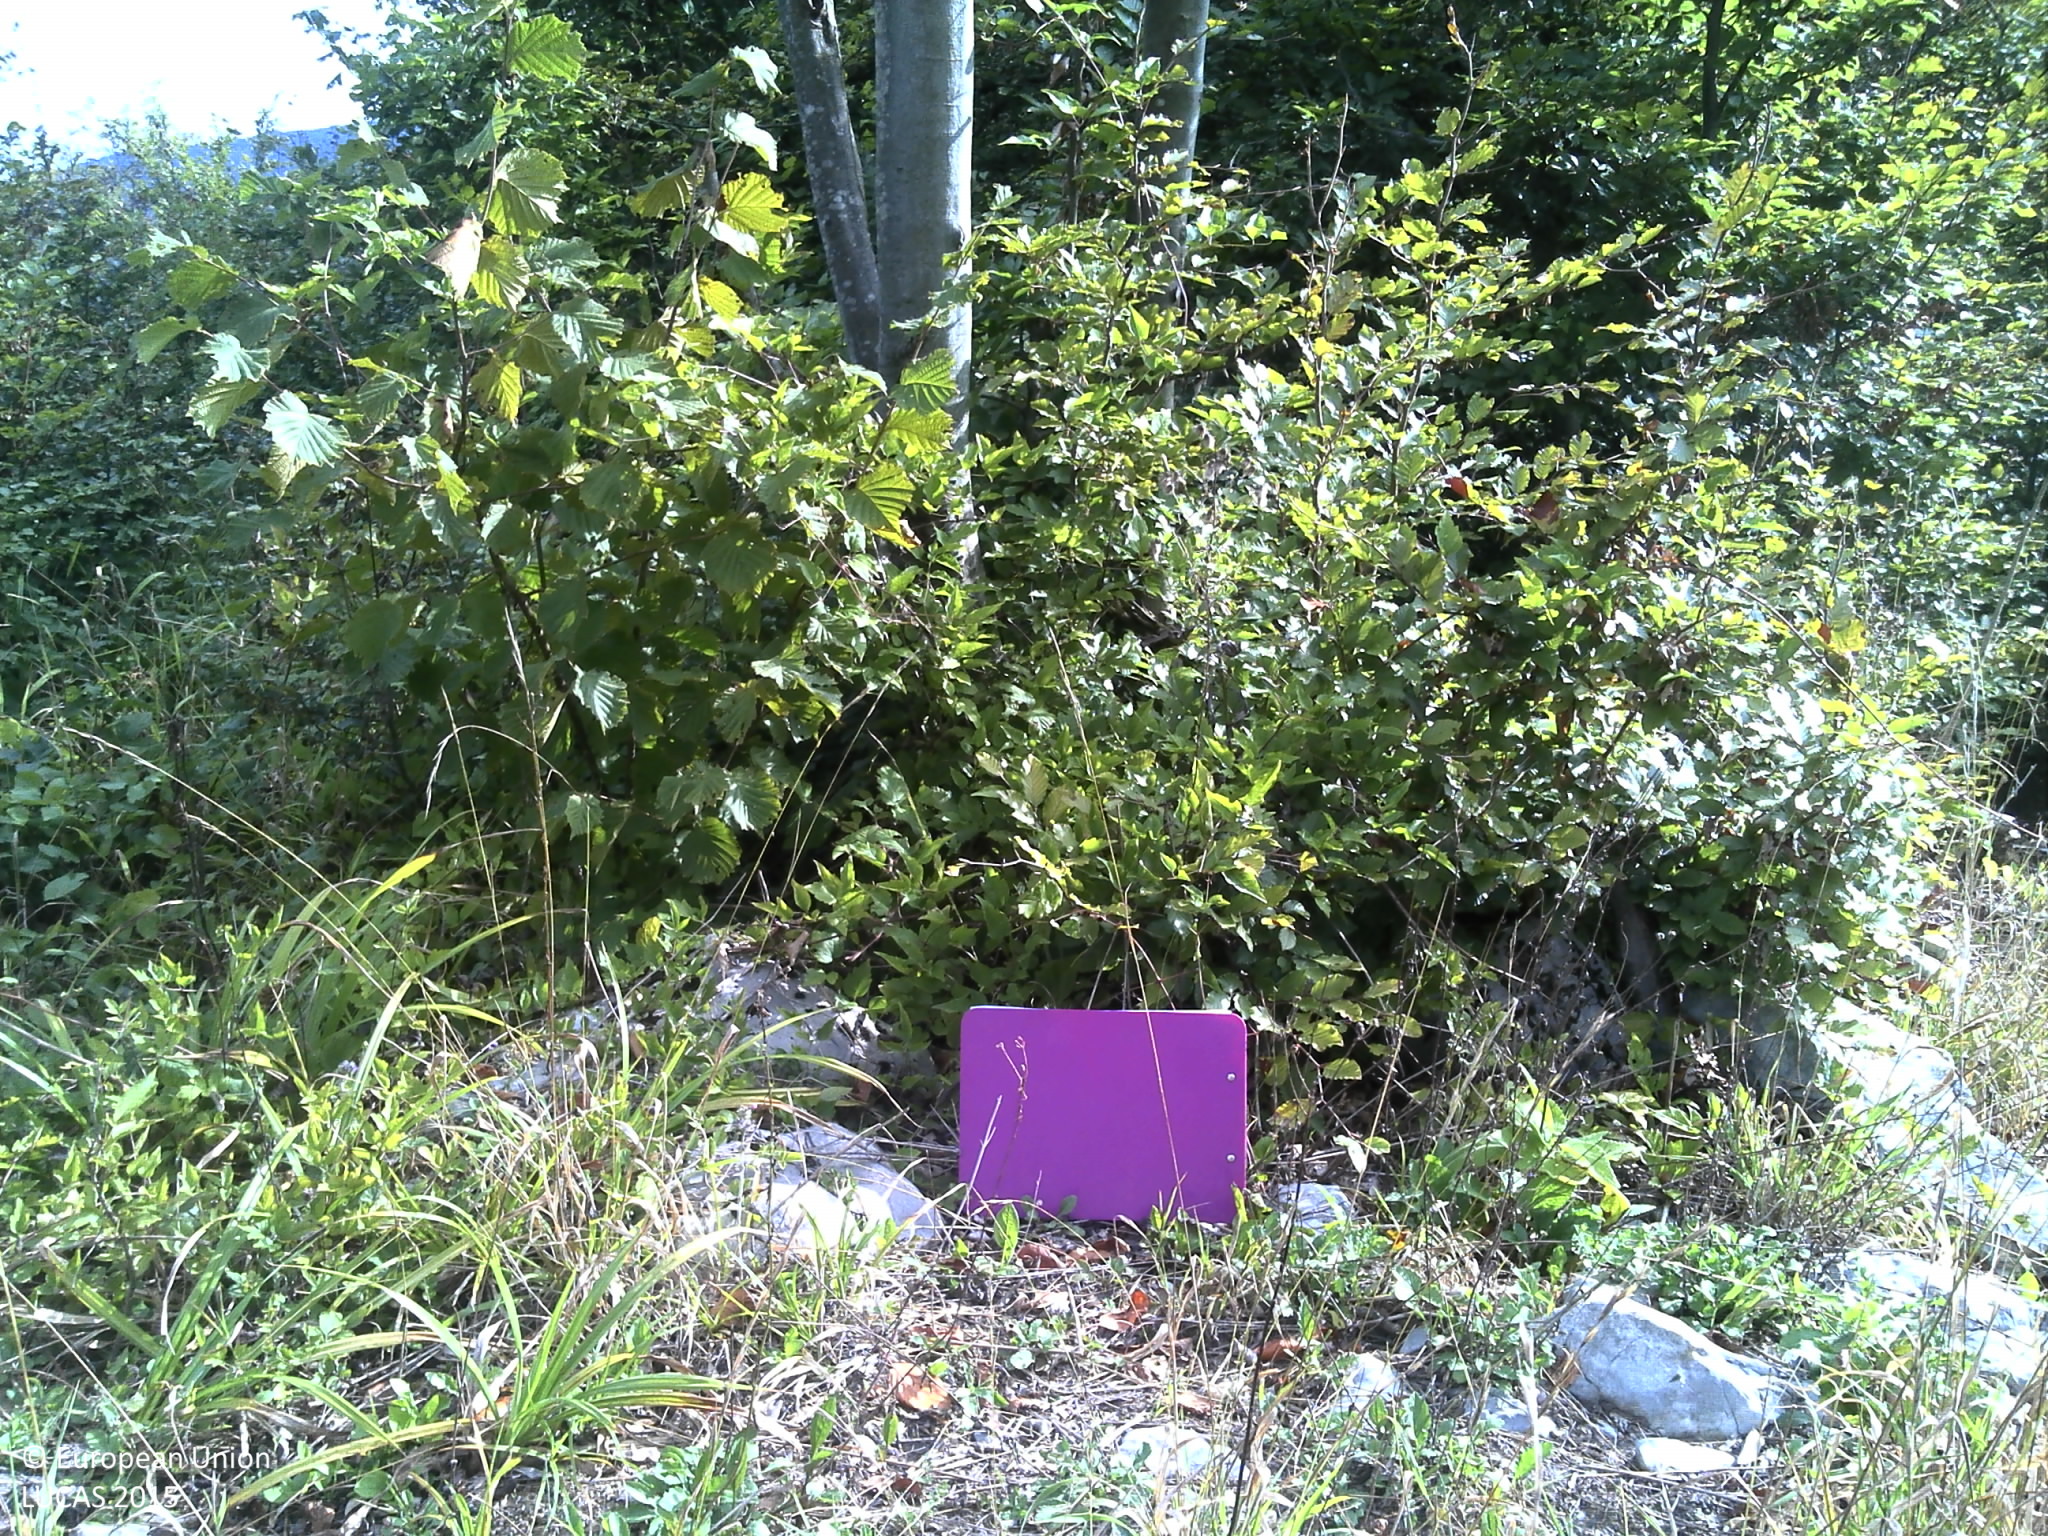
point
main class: Woodland
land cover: Broadleaved woodland
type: beech forest
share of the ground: > 75 %
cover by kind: broadleaved forest trees 100 %
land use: Forestry
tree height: > 5 m
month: September
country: HR
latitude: 45.3215
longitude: 15.2132
